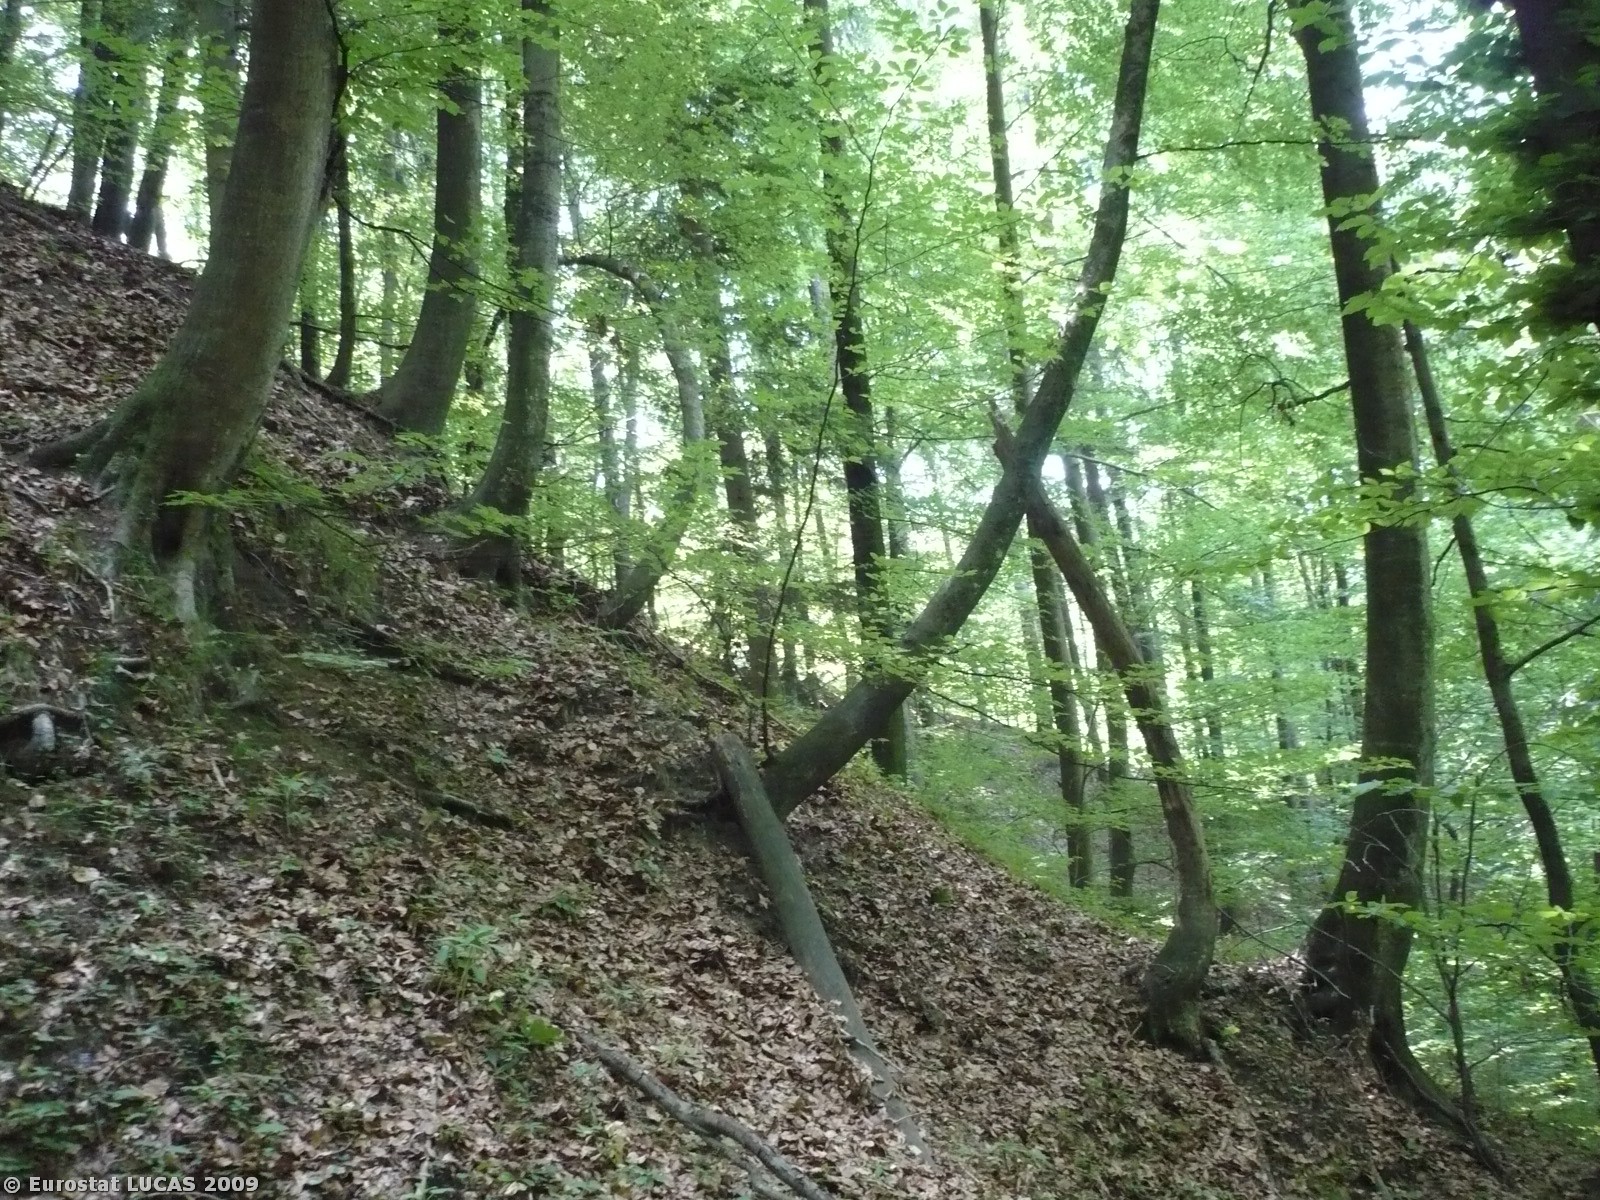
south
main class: Woodland
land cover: Mixed woodland
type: beech forest
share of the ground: > 75 %
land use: Forestry
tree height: > 5 m
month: May
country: SI
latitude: 46.3211
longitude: 14.2439
